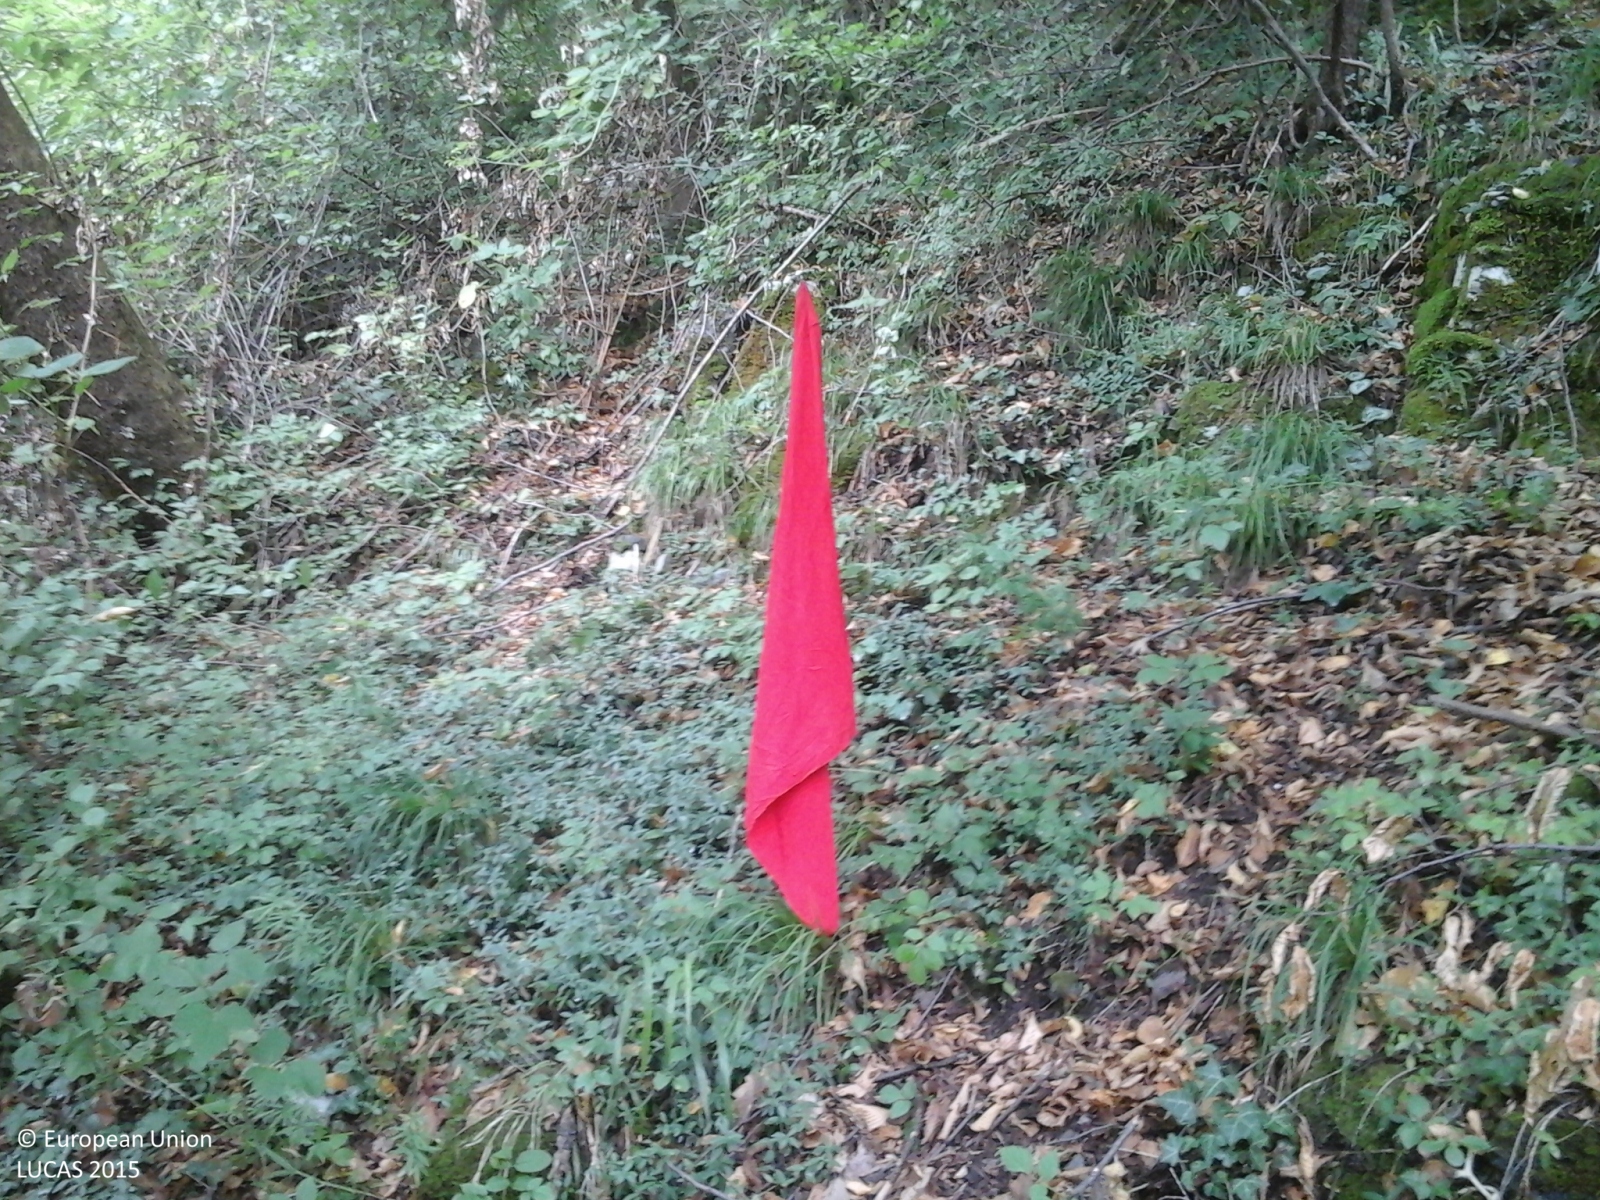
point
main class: Woodland
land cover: Broadleaved woodland
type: thermophilous deciduous forest
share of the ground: > 75 %
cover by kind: broadleaved forest trees 100 %
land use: Forestry
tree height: > 5 m
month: July
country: IT
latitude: 45.8805
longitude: 9.2924
